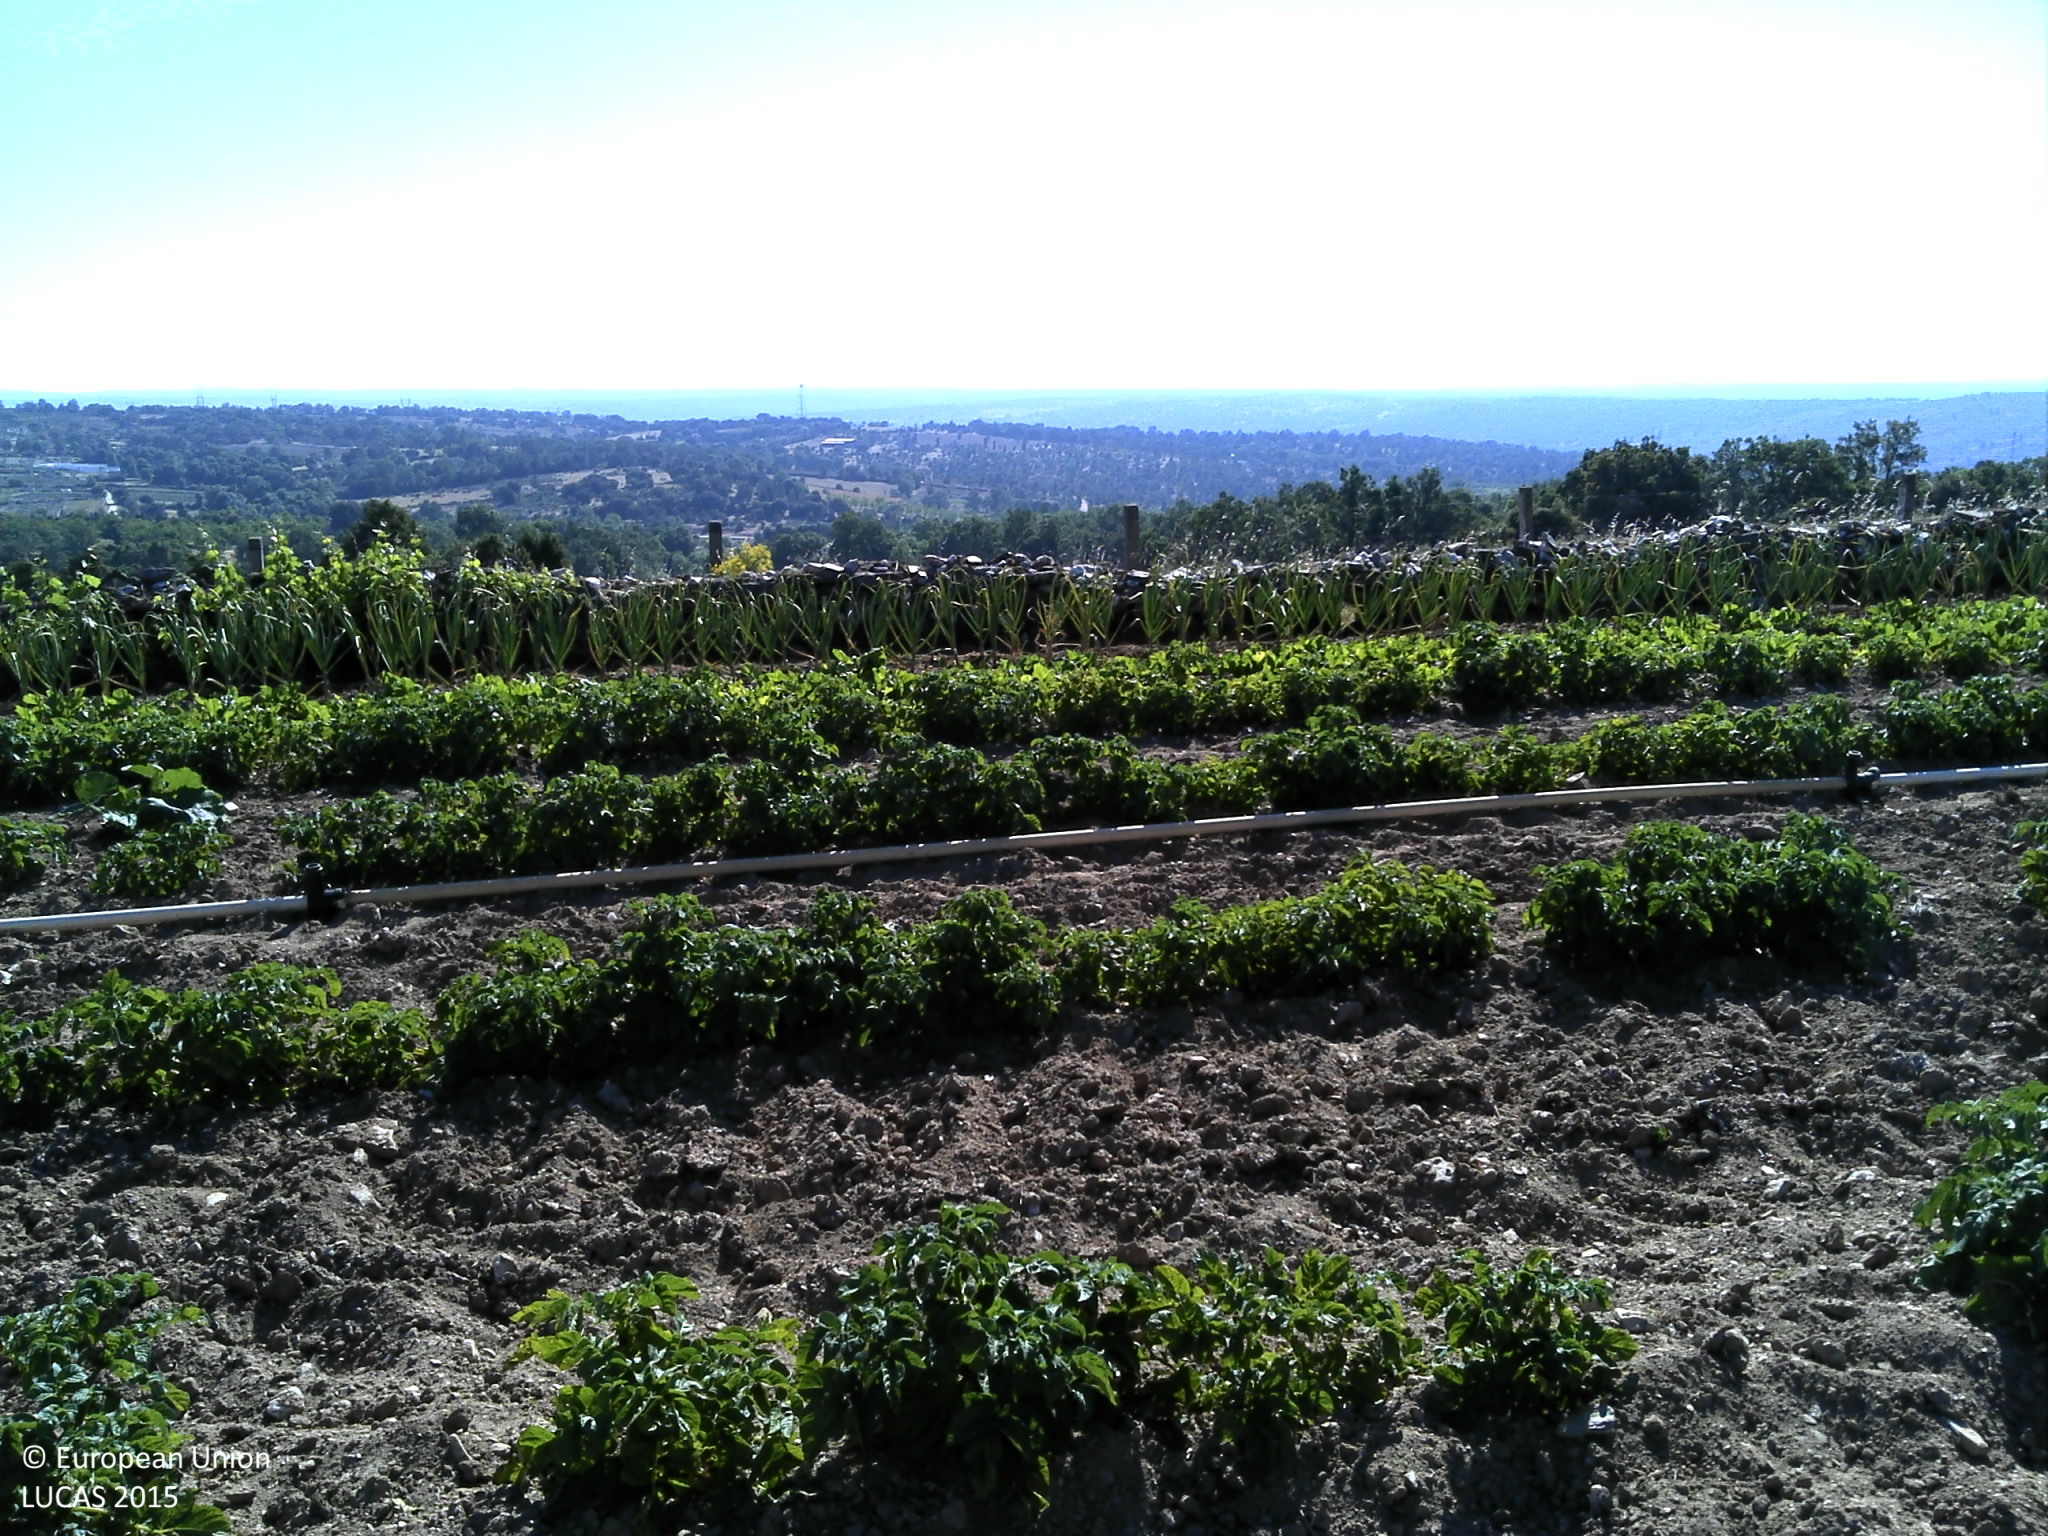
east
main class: Cropland
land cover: Potatoes
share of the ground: < 10 %
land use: Agriculture (excluding fallow land and kitchen gardens)
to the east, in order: Potatoes; Other fresh vegetables; Dry stone walls; Grass margins; Tracks; Grass margins; Fences; Other bare soil; Grass margins; Other bare soil; Abandoned hedges; Fences; Abandoned hedges; Grassland with sparse tree/shrub cover; Abandoned hedges; Other bare soil
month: May
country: PT
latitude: 41.4667
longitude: -6.3221
